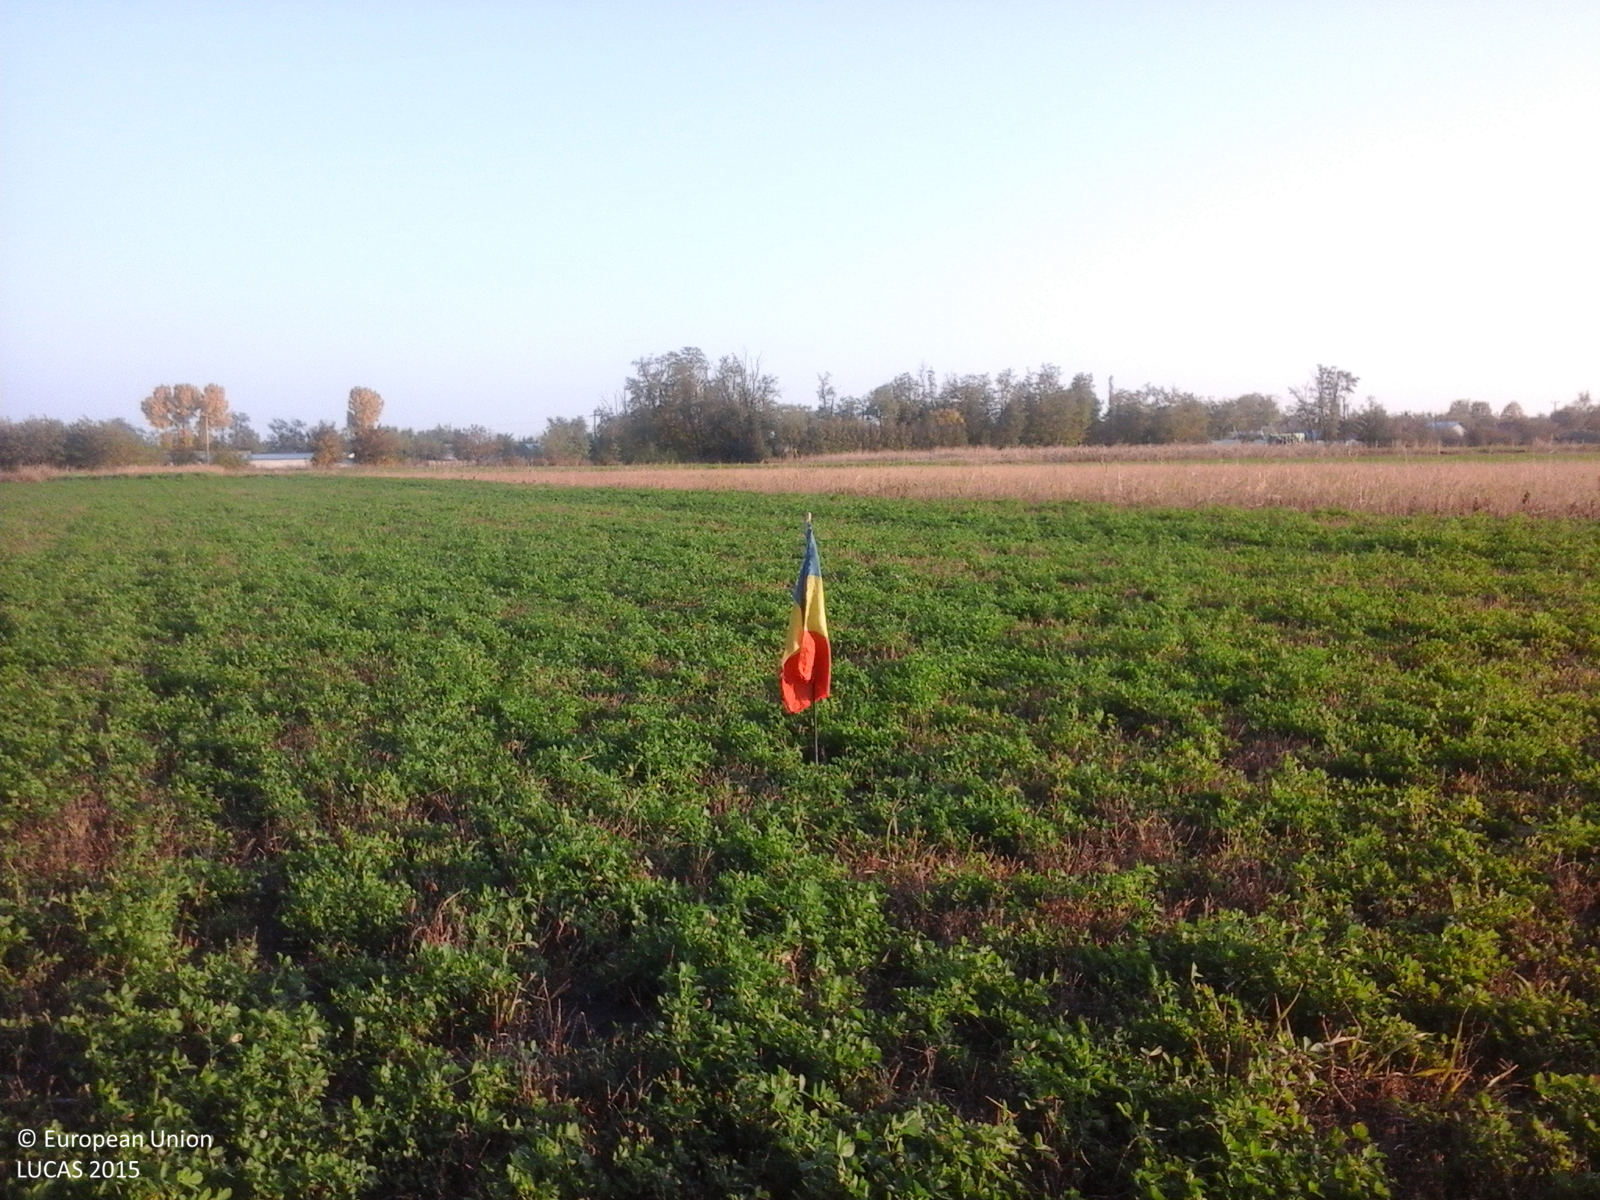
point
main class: Cropland
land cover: Lucerne
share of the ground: > 75 %
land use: Agriculture (excluding fallow land and kitchen gardens)
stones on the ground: < 10 %
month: October
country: RO
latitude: 45.1318
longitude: 26.9563
